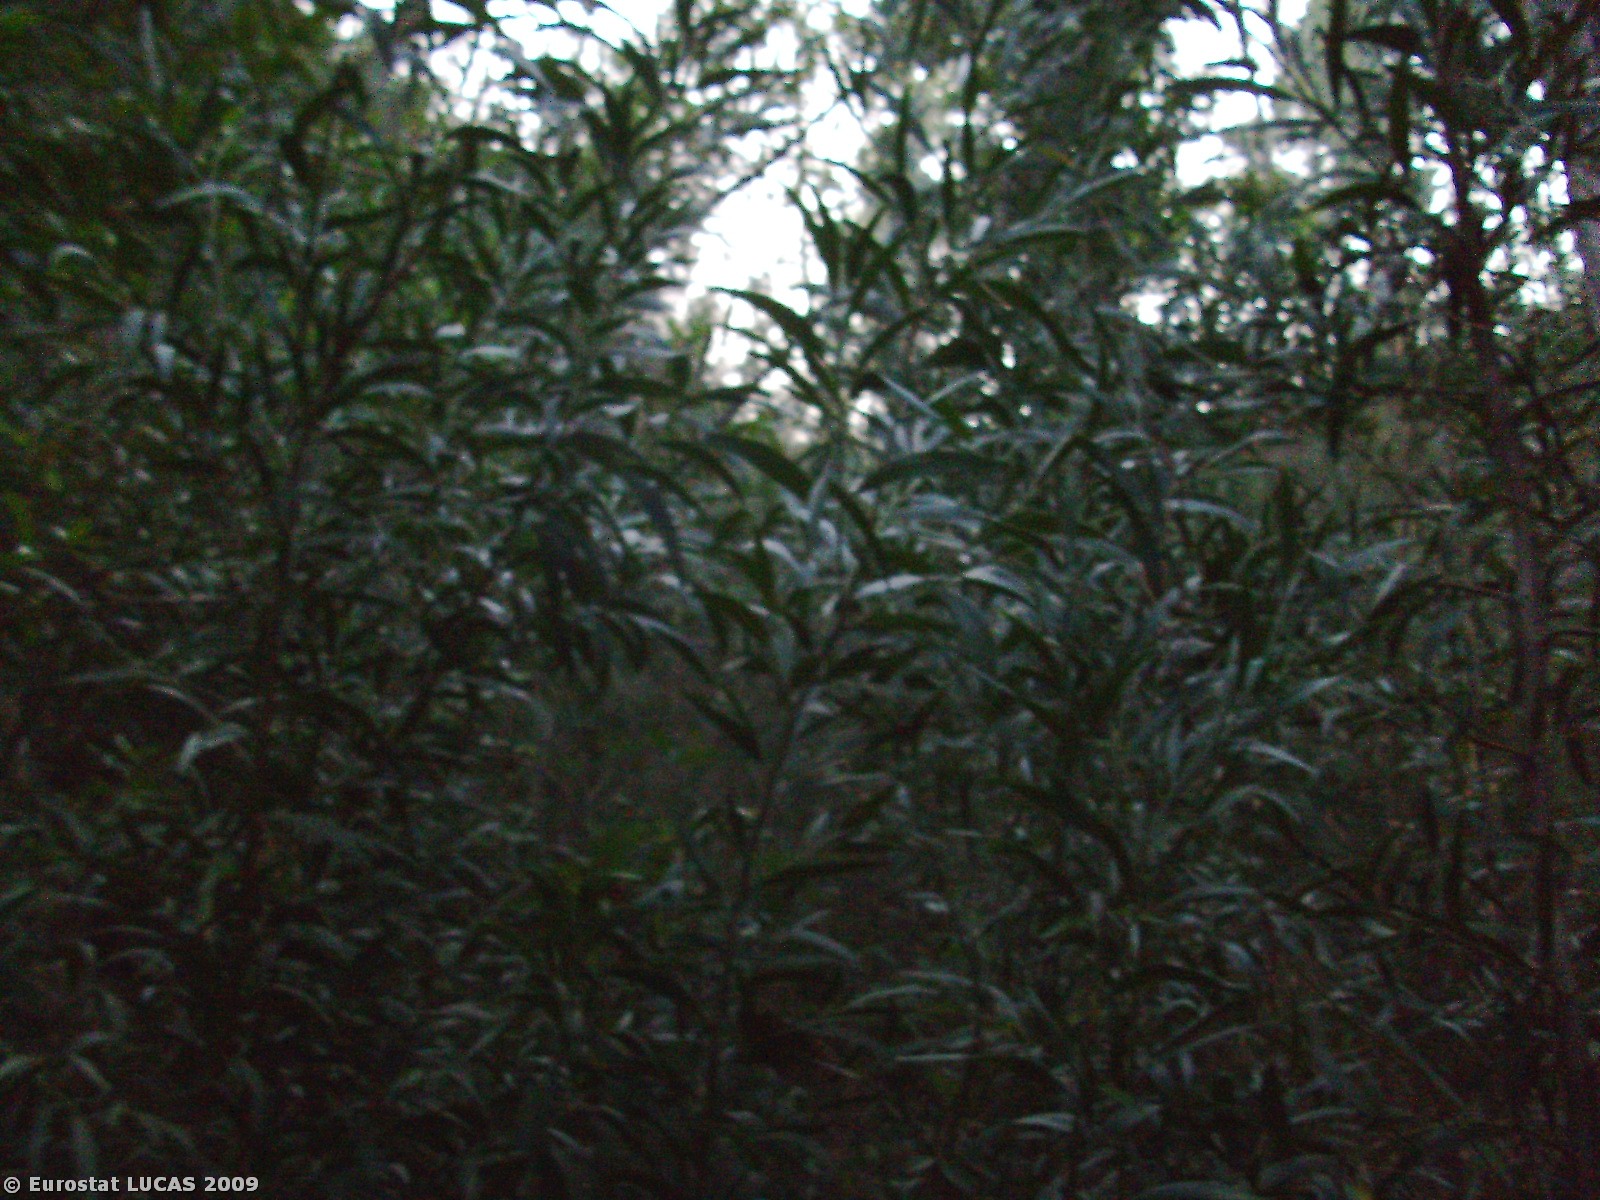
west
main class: Woodland
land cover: Broadleaved woodland
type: thermophilous deciduous forest
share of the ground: 25 - 50 %
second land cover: Shrubland with sparse tree cover
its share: 50 - 75 %
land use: Forestry
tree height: > 5 m
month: August
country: PT
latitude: 40.0583
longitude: -8.3313
